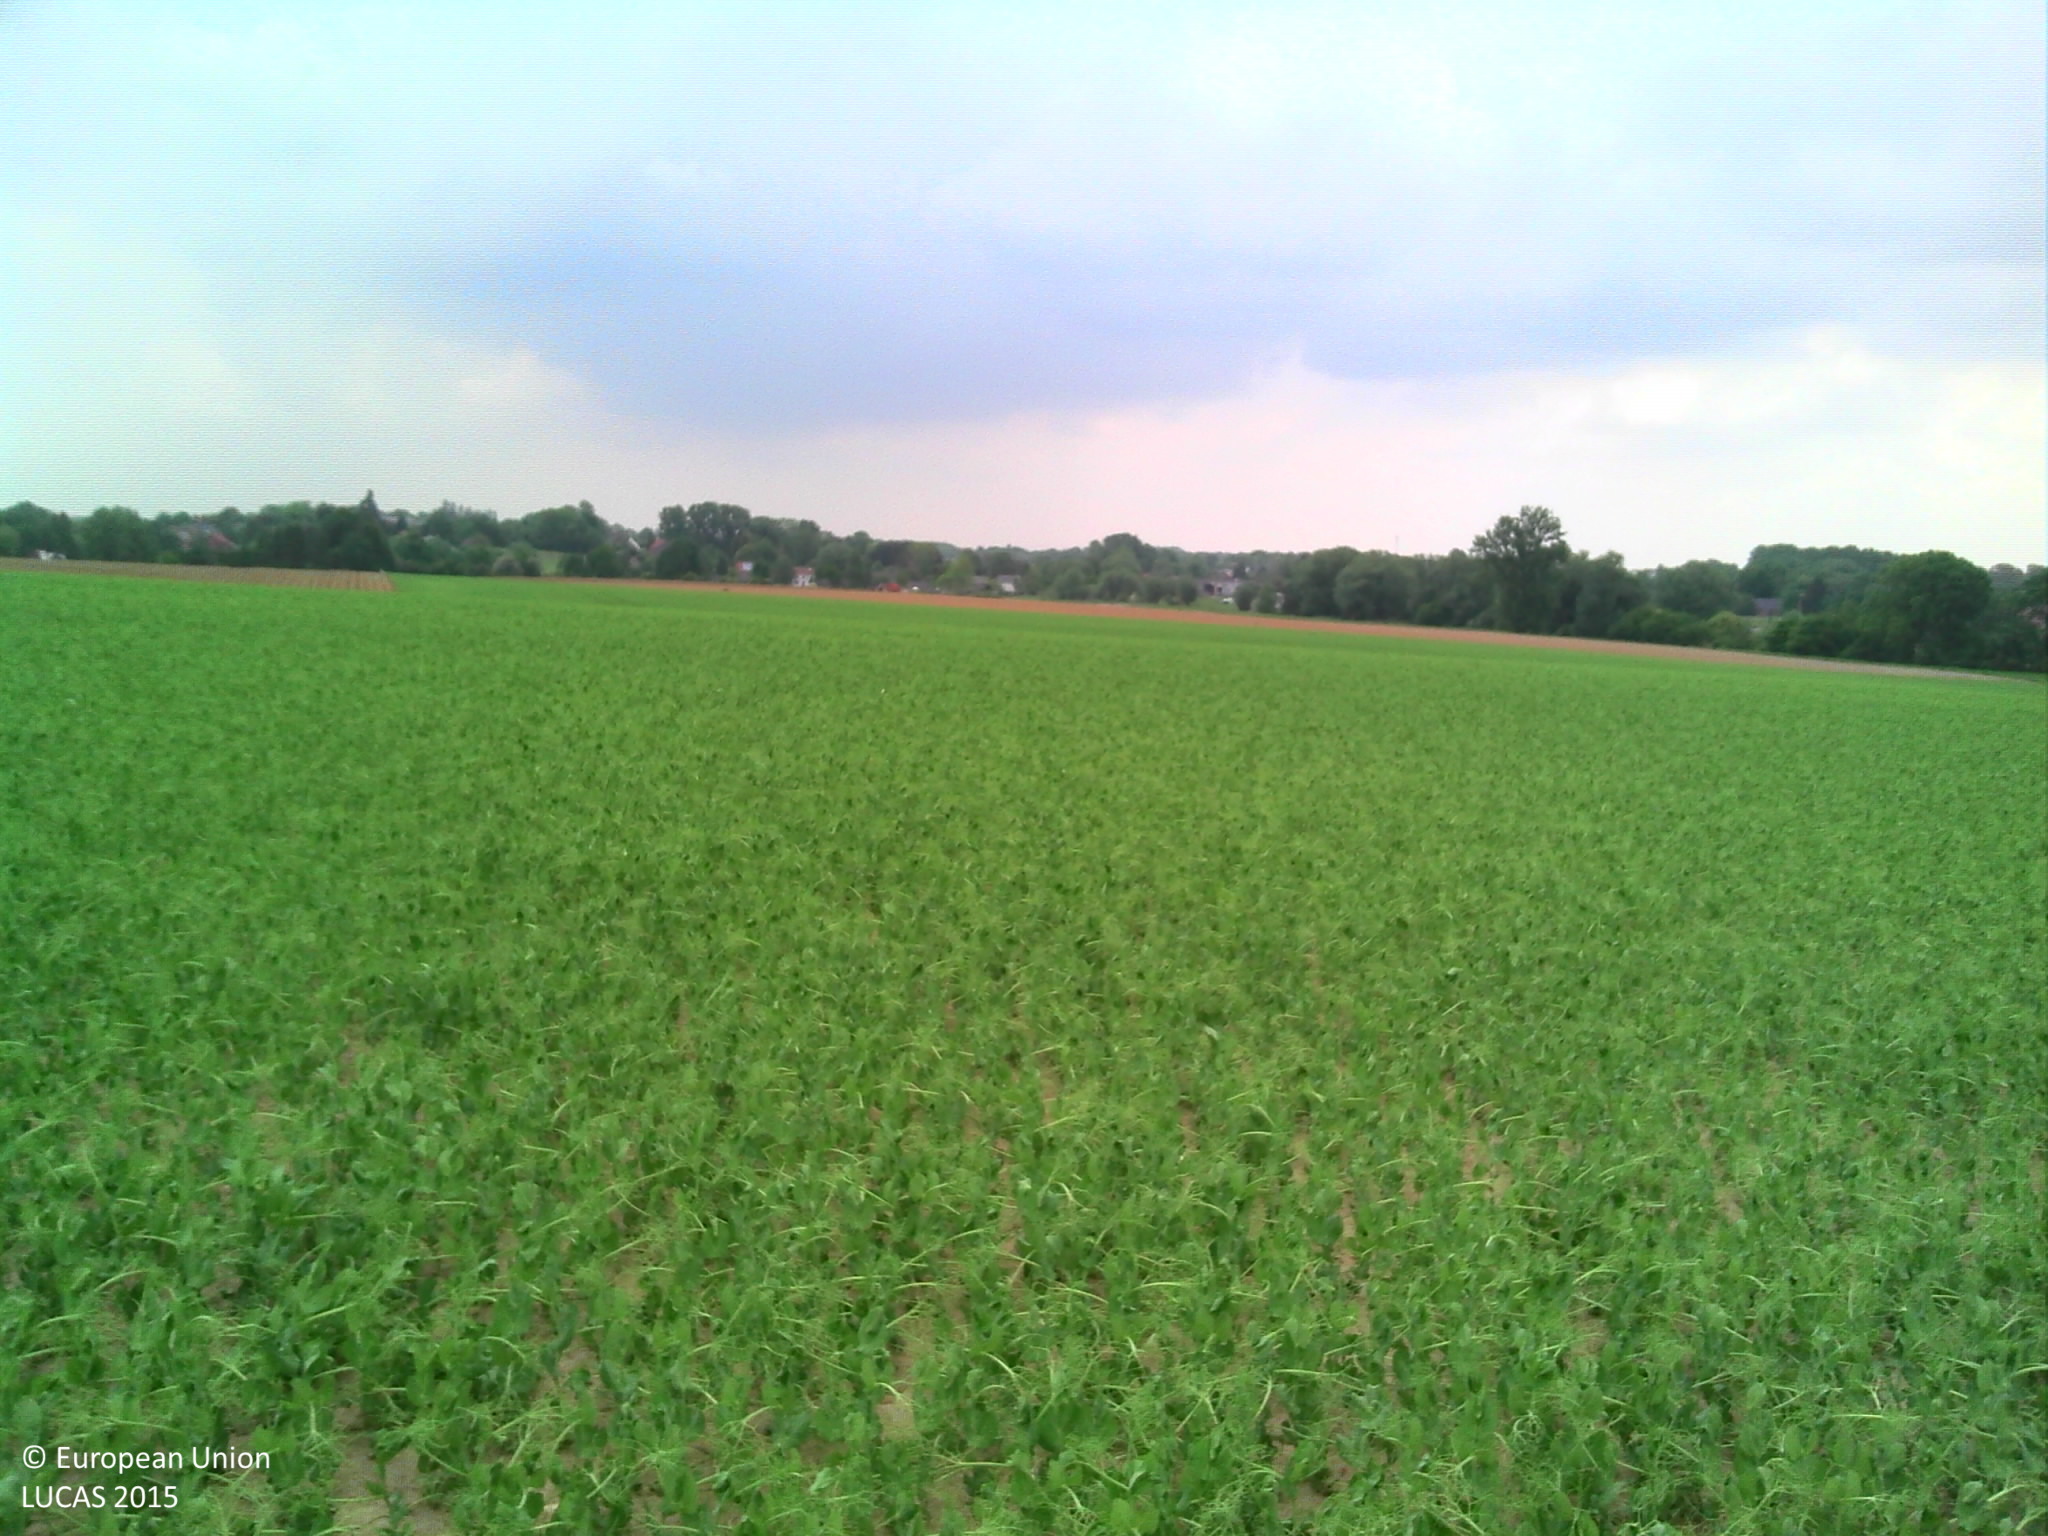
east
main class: Cropland
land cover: Dry pulses
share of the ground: > 75 %
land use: Agriculture (excluding fallow land and kitchen gardens)
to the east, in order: Dry pulses
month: May
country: BE
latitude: 50.6451
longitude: 4.8633
